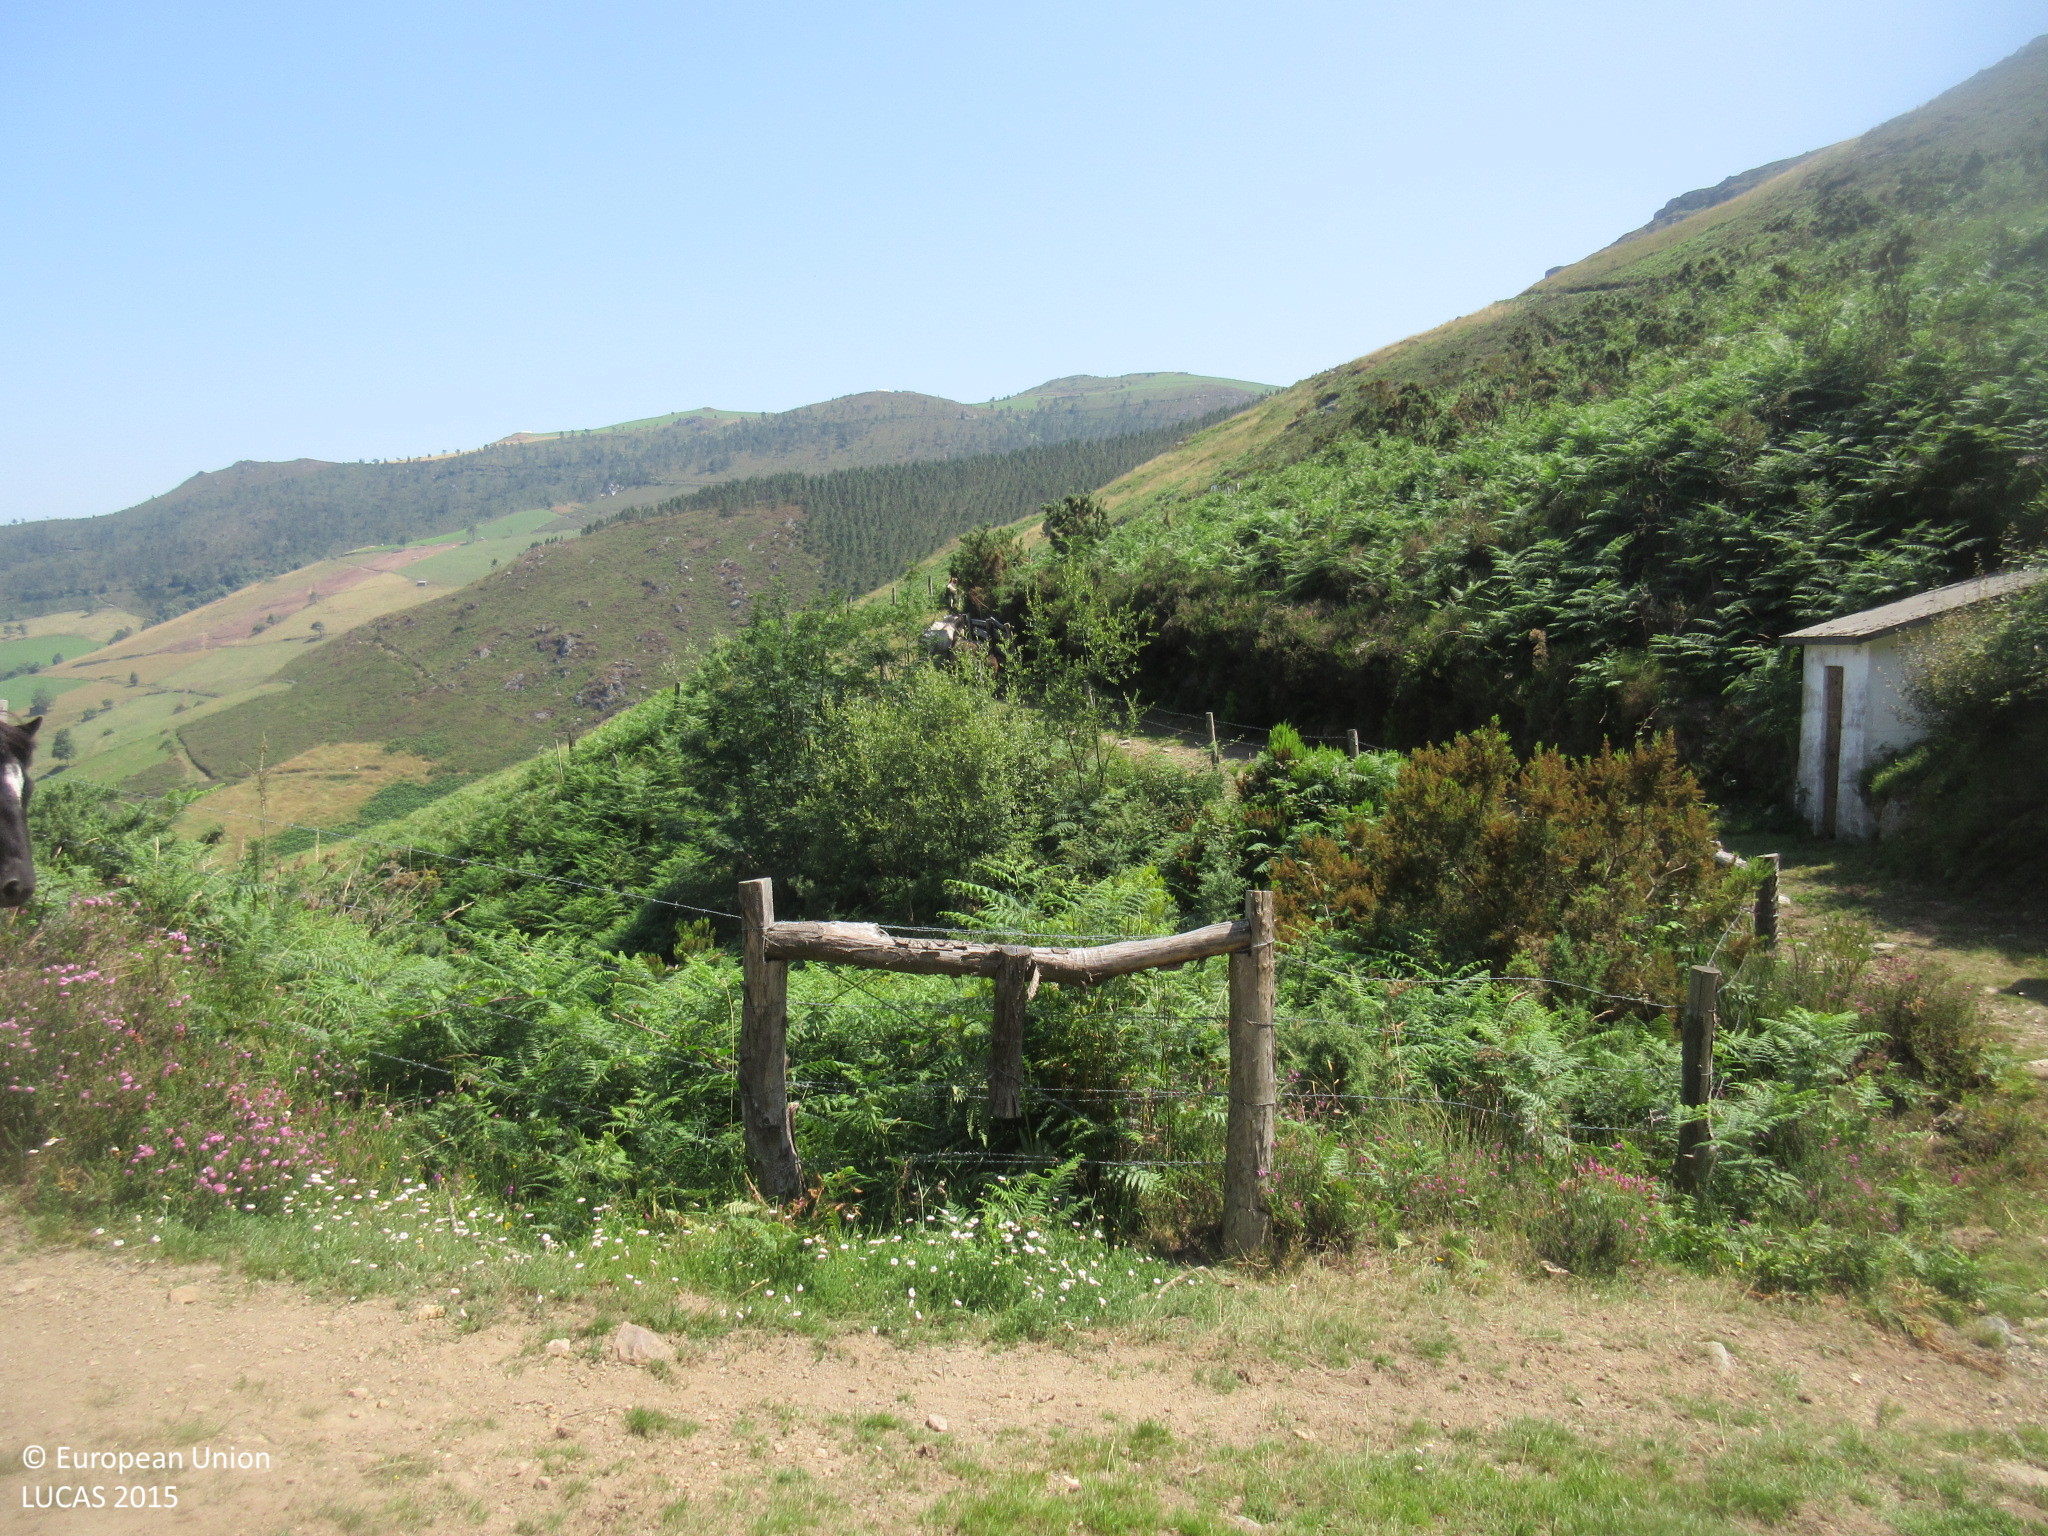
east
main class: Shrubland
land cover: Shrubland without tree cover
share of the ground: > 75 %
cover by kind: shrubs 100 %
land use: Agriculture (excluding fallow land and kitchen gardens)
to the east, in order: Shrubland without tree cover; Tracks; Shrubland without tree cover; Tracks; Shrubland without tree cover
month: July
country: ES
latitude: 43.4312
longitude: -6.6742
